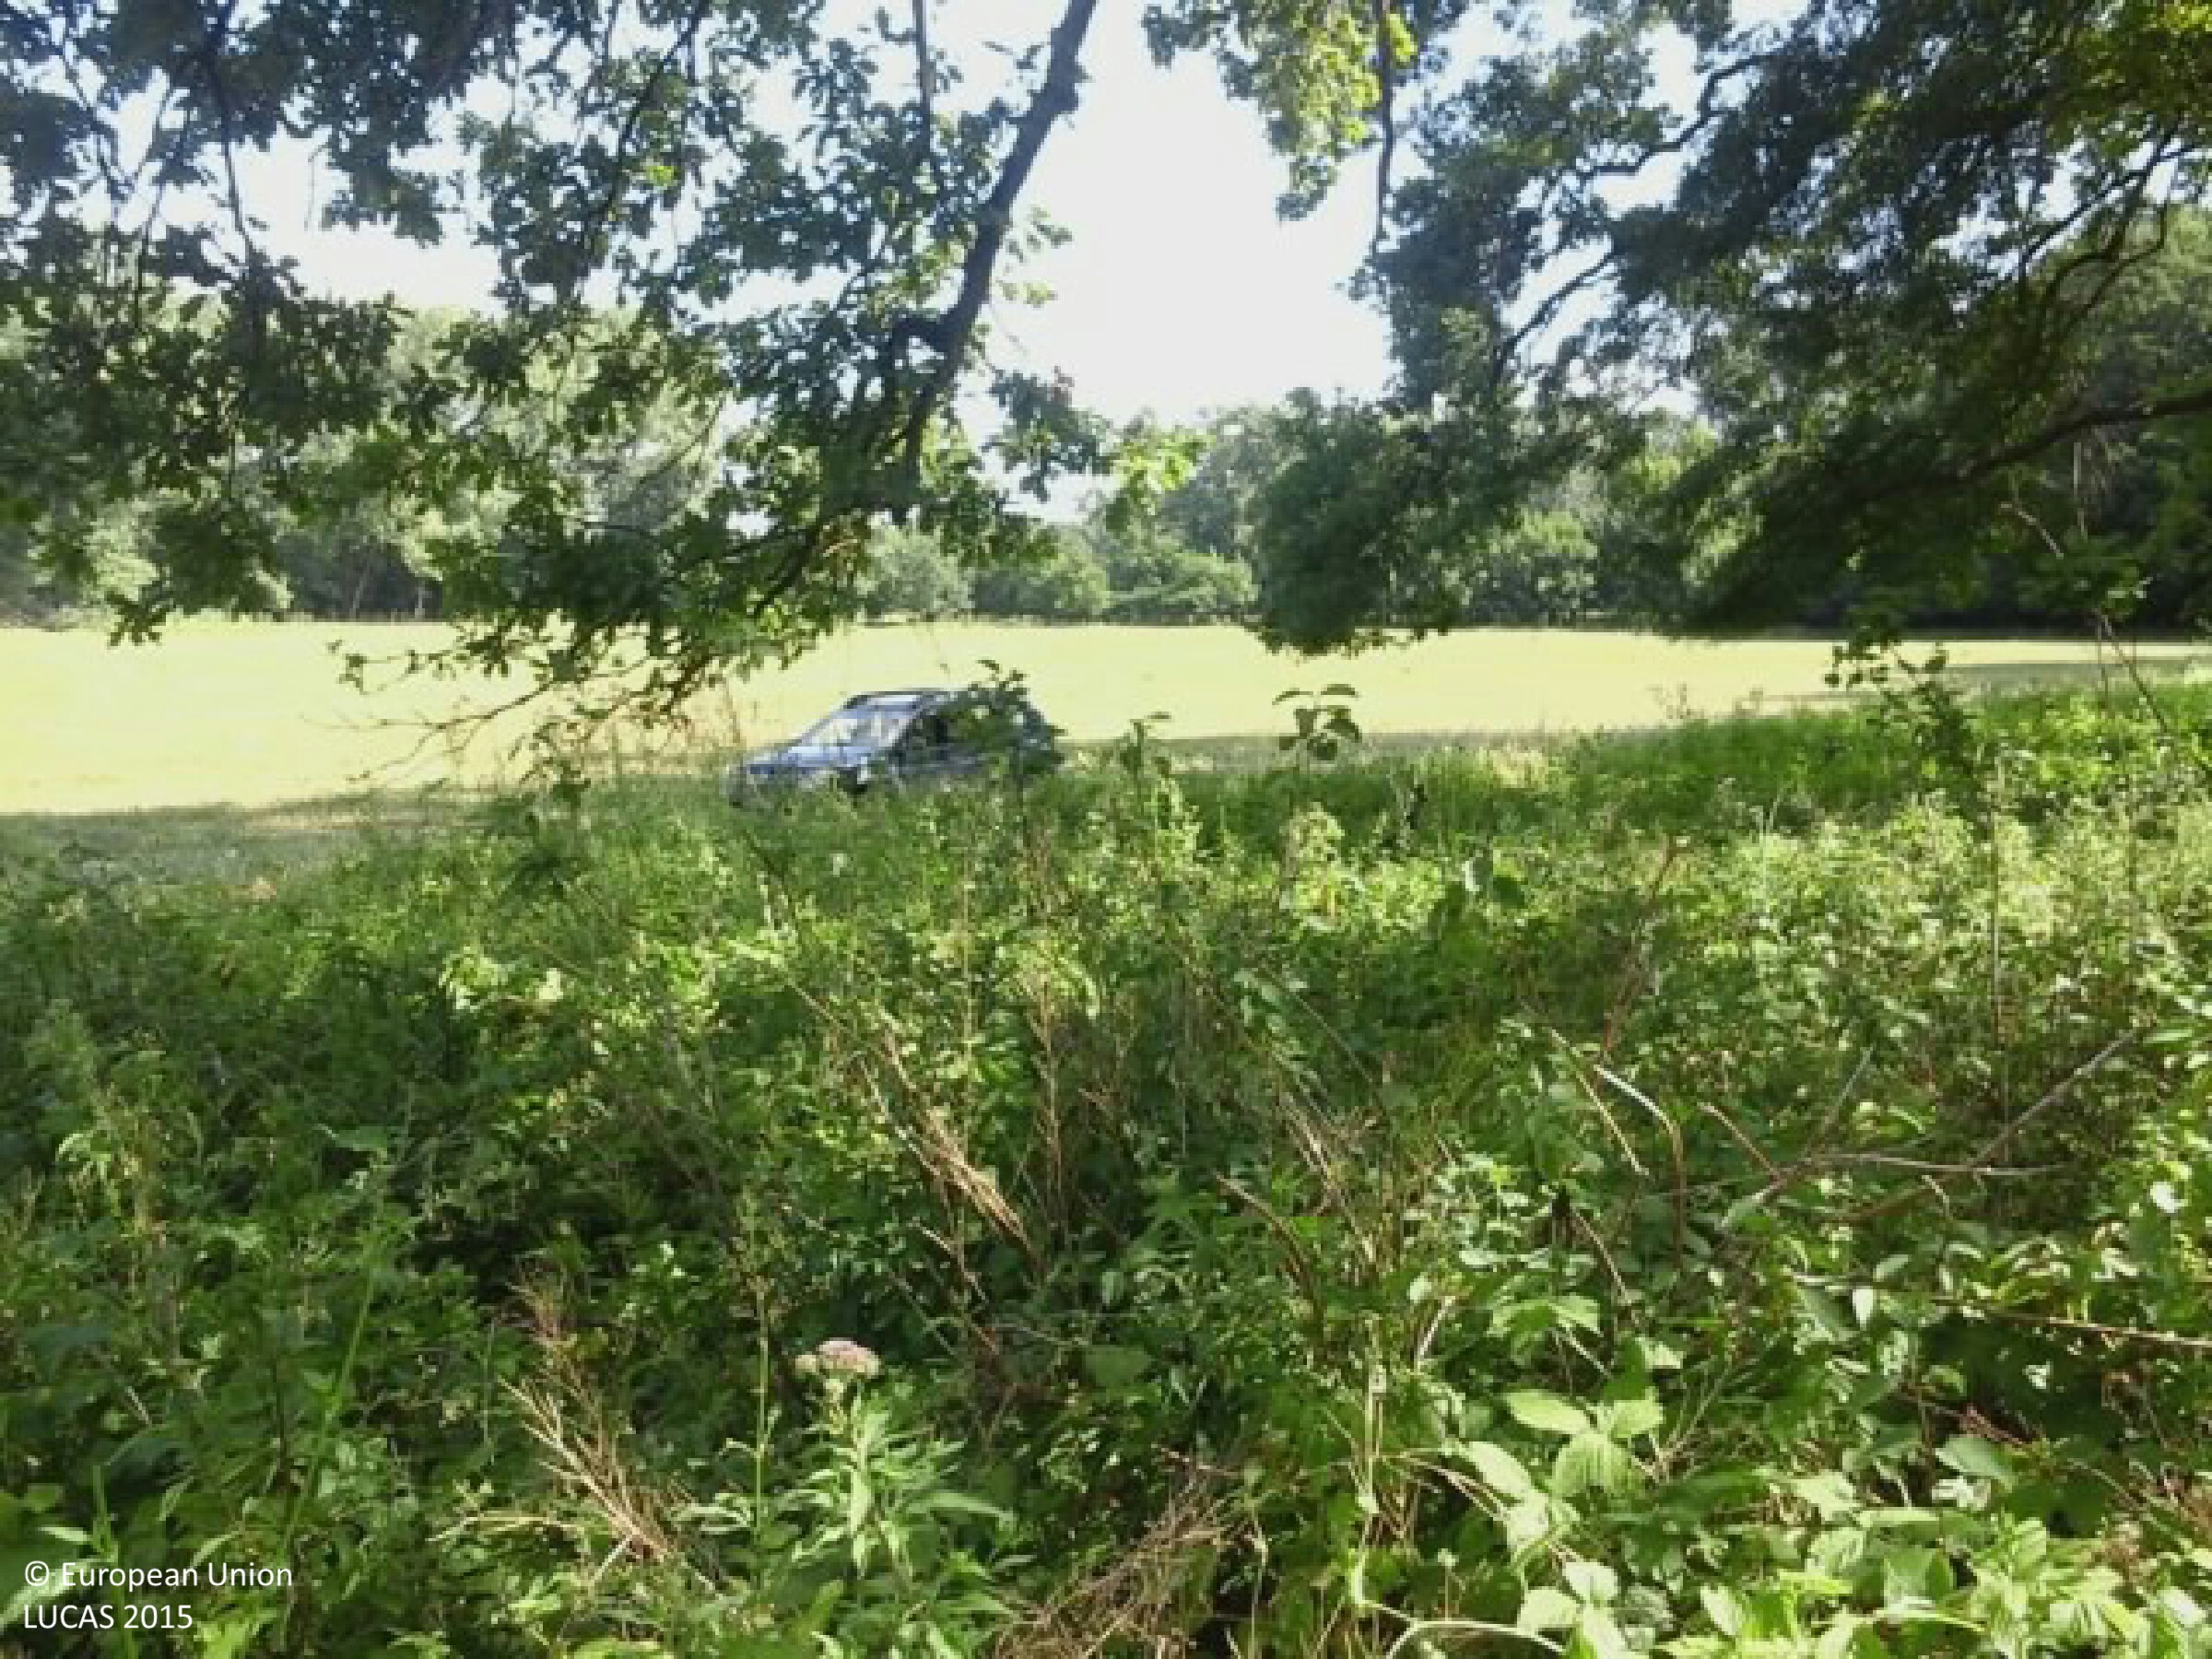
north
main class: Woodland
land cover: Broadleaved woodland
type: mesophytic deciduous forest
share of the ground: 25 - 50 %
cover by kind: broadleaved forest trees 60 %, herbaceous plants 25 %, shrubs 15 %
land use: Forestry
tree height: < 5 m
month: July
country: HU
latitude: 46.3252
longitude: 18.8834
